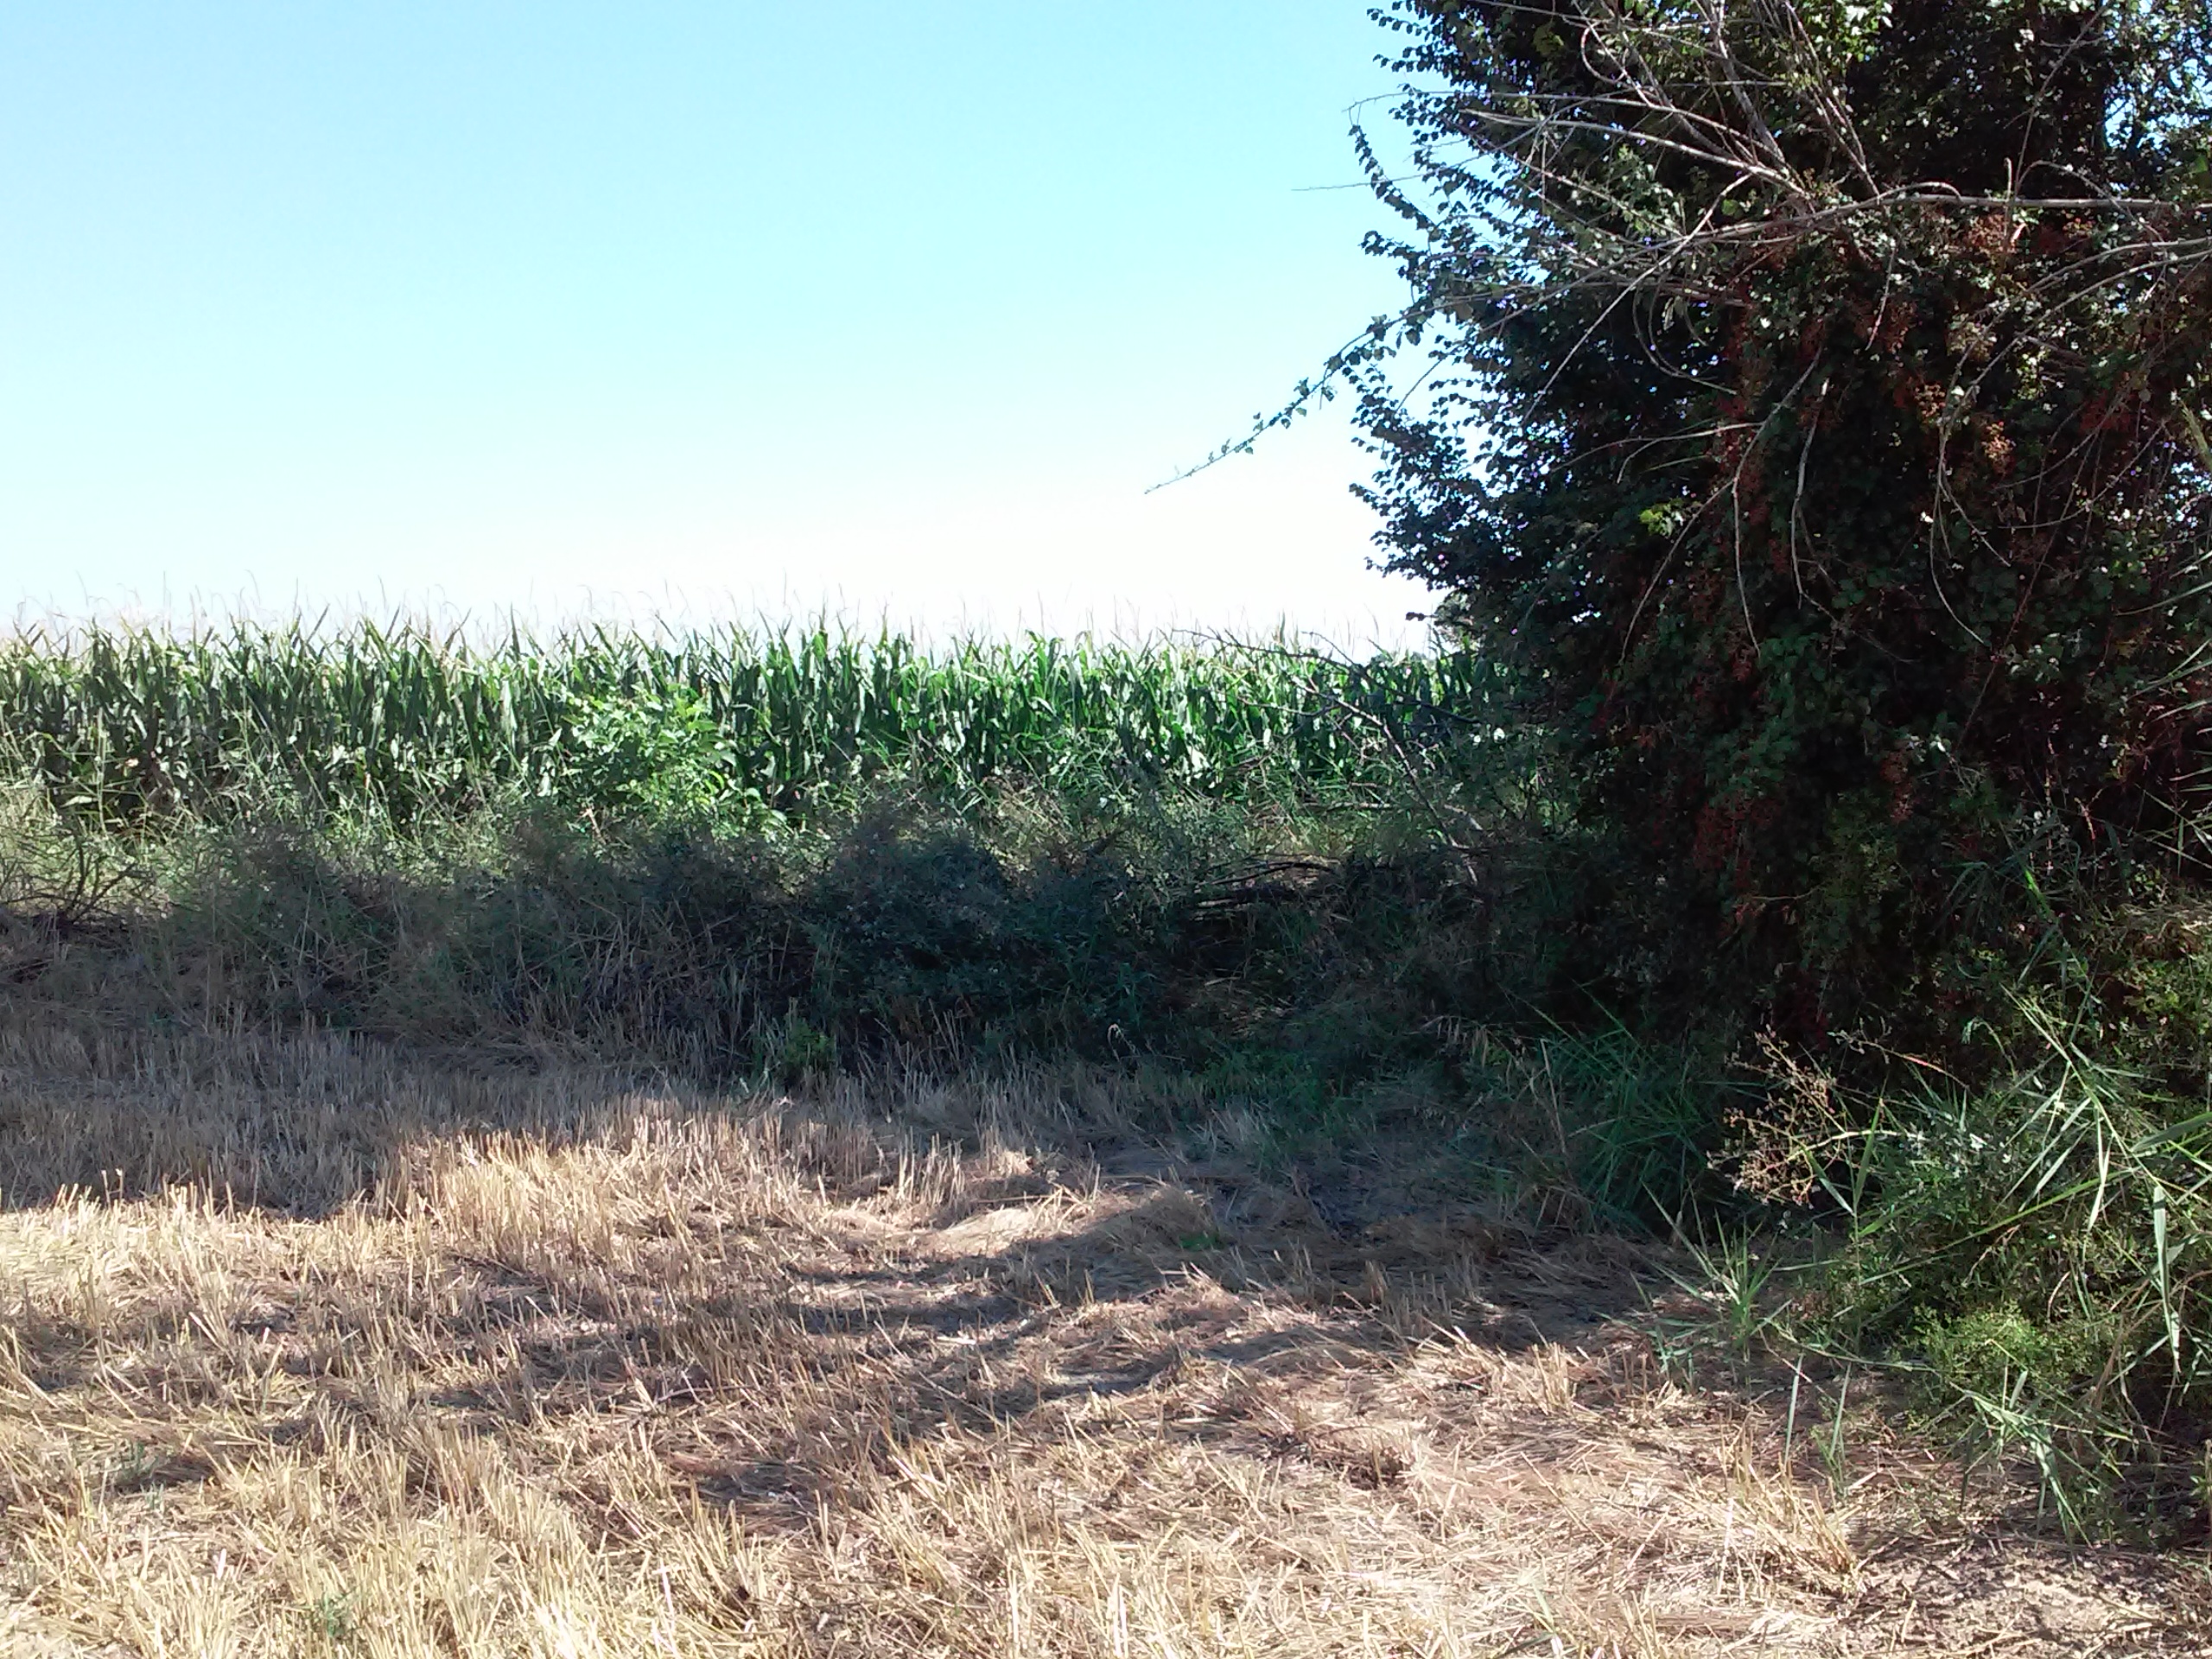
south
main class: Cropland
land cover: Common wheat
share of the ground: < 10 %
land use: Agriculture (excluding fallow land and kitchen gardens)
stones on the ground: 10 - 25 %
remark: Harvested field
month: July
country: ES
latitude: 41.7430
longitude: 0.5954
